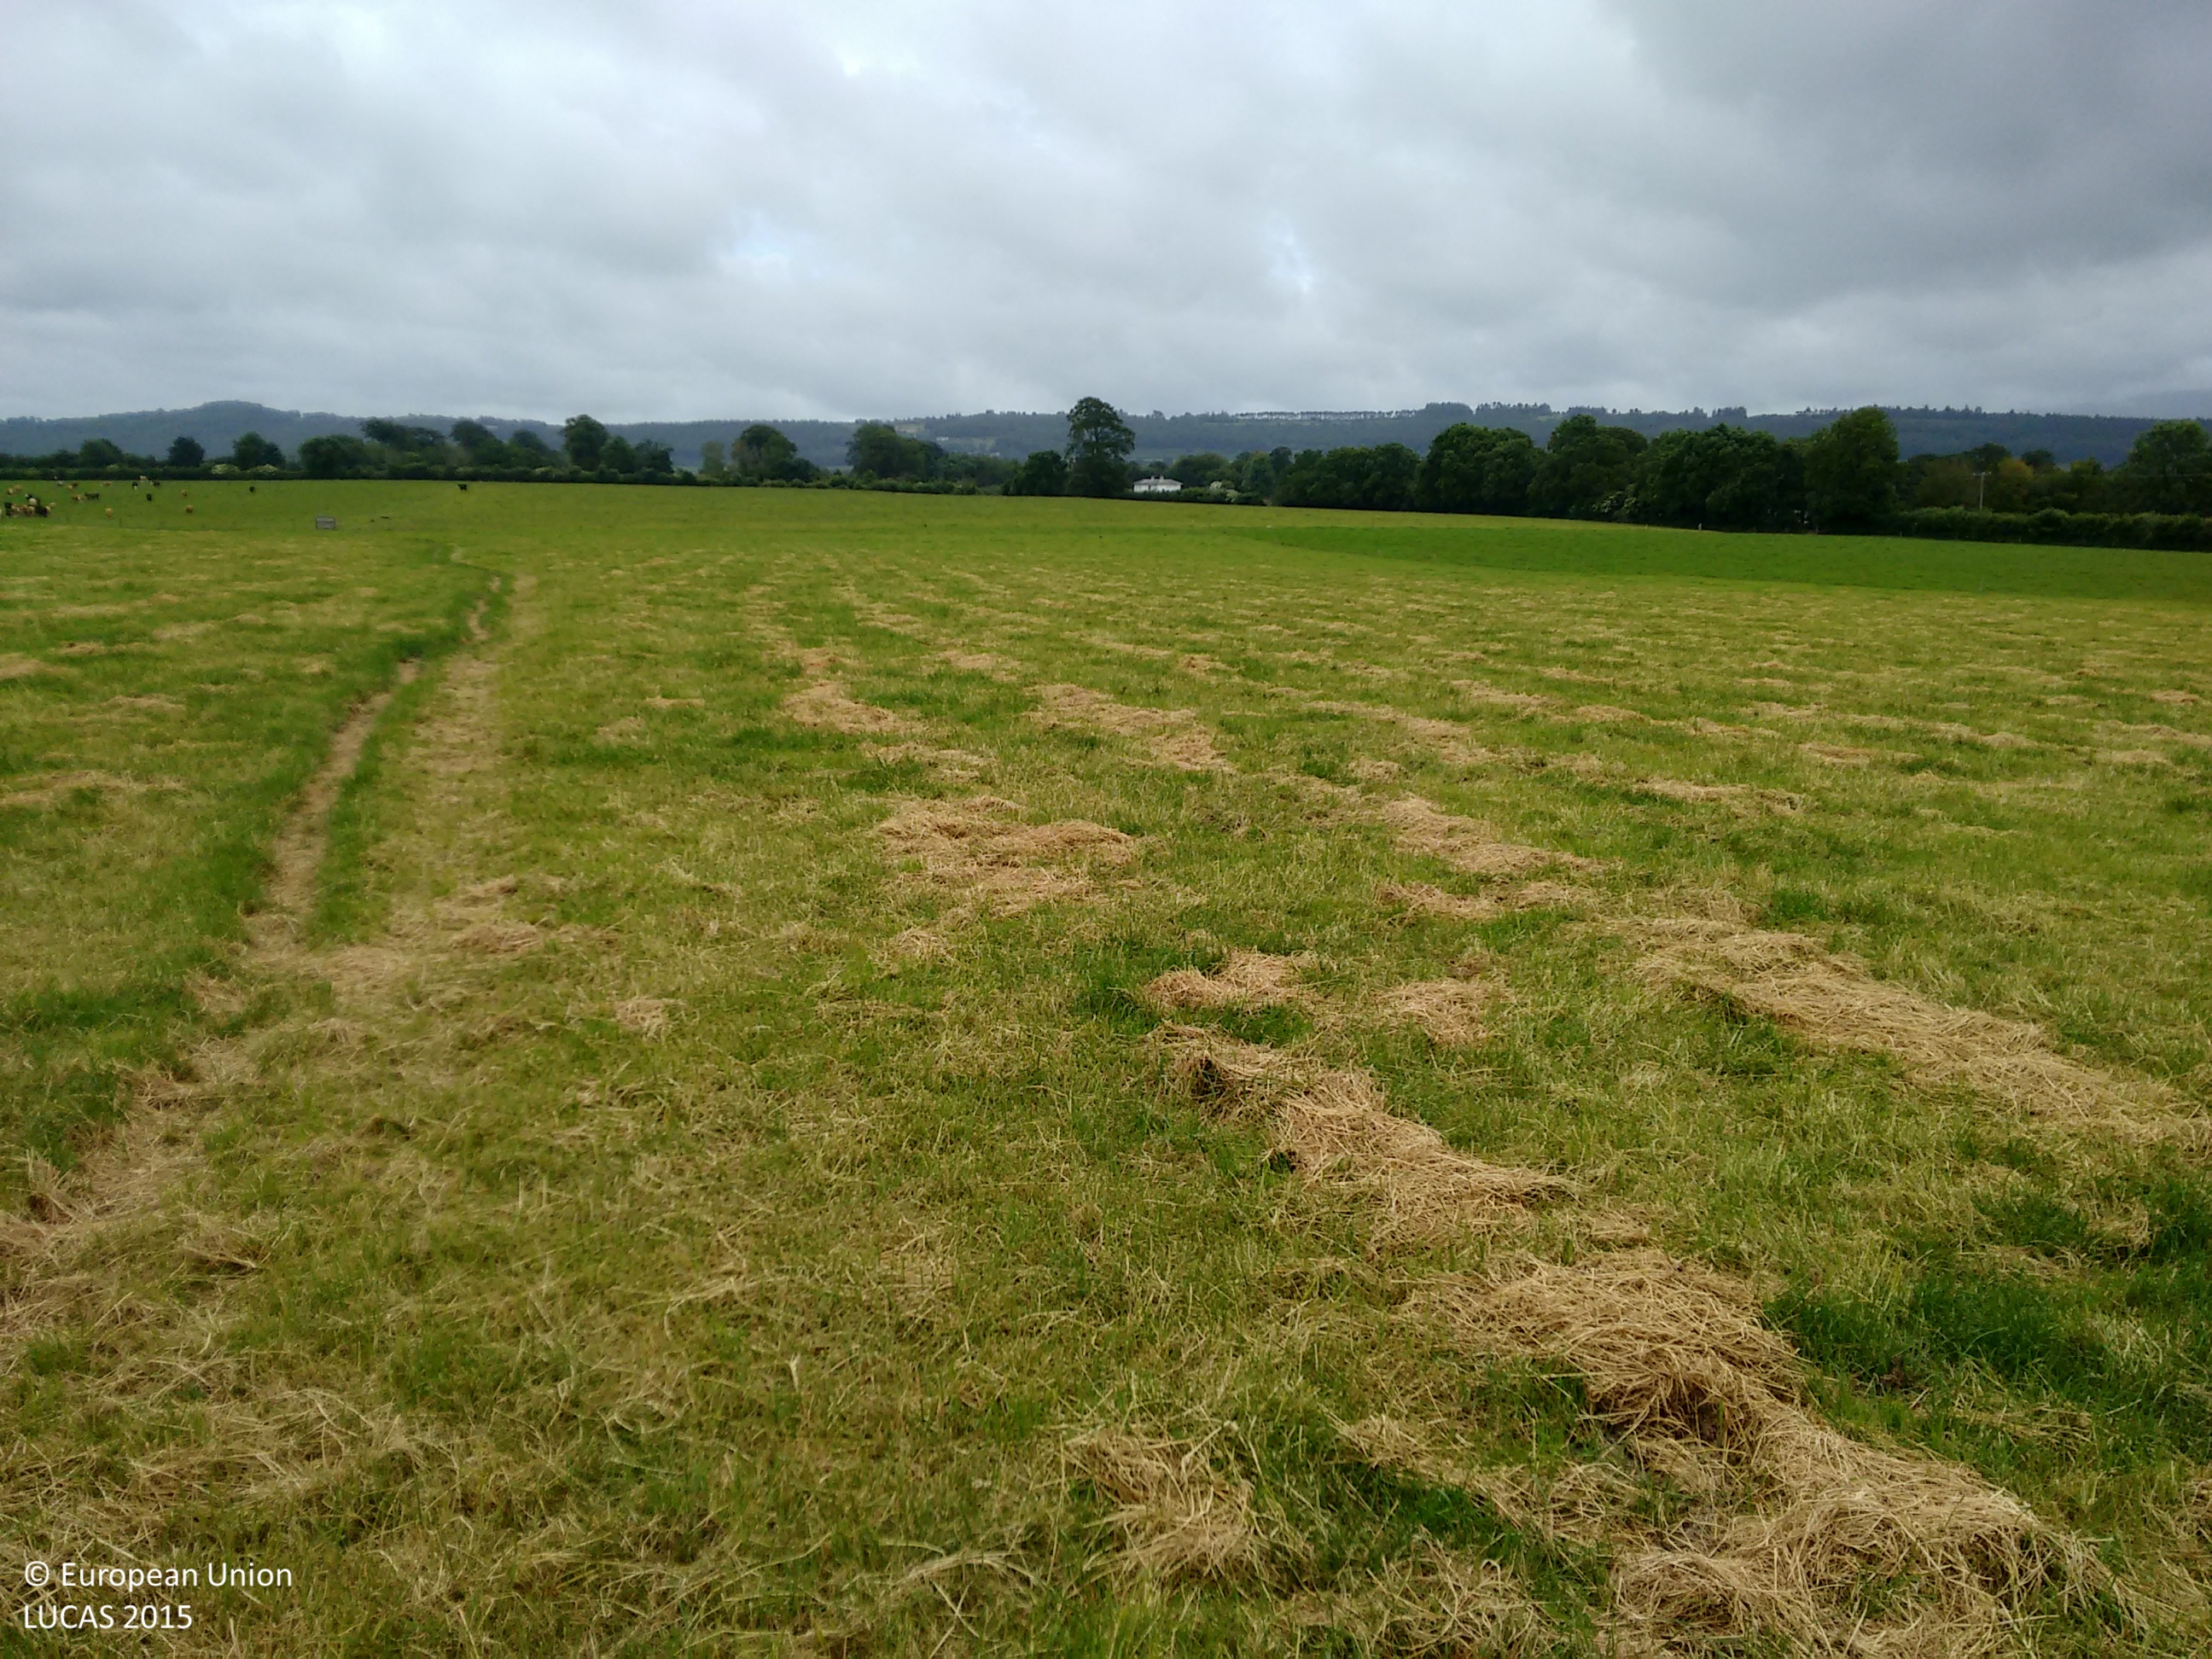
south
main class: Grassland
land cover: Grassland without tree/shrub cover
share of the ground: > 75 %
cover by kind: herbaceous plants 100 %
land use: Agriculture (excluding fallow land and kitchen gardens)
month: June
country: IE
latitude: 52.3653
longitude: -7.4120
